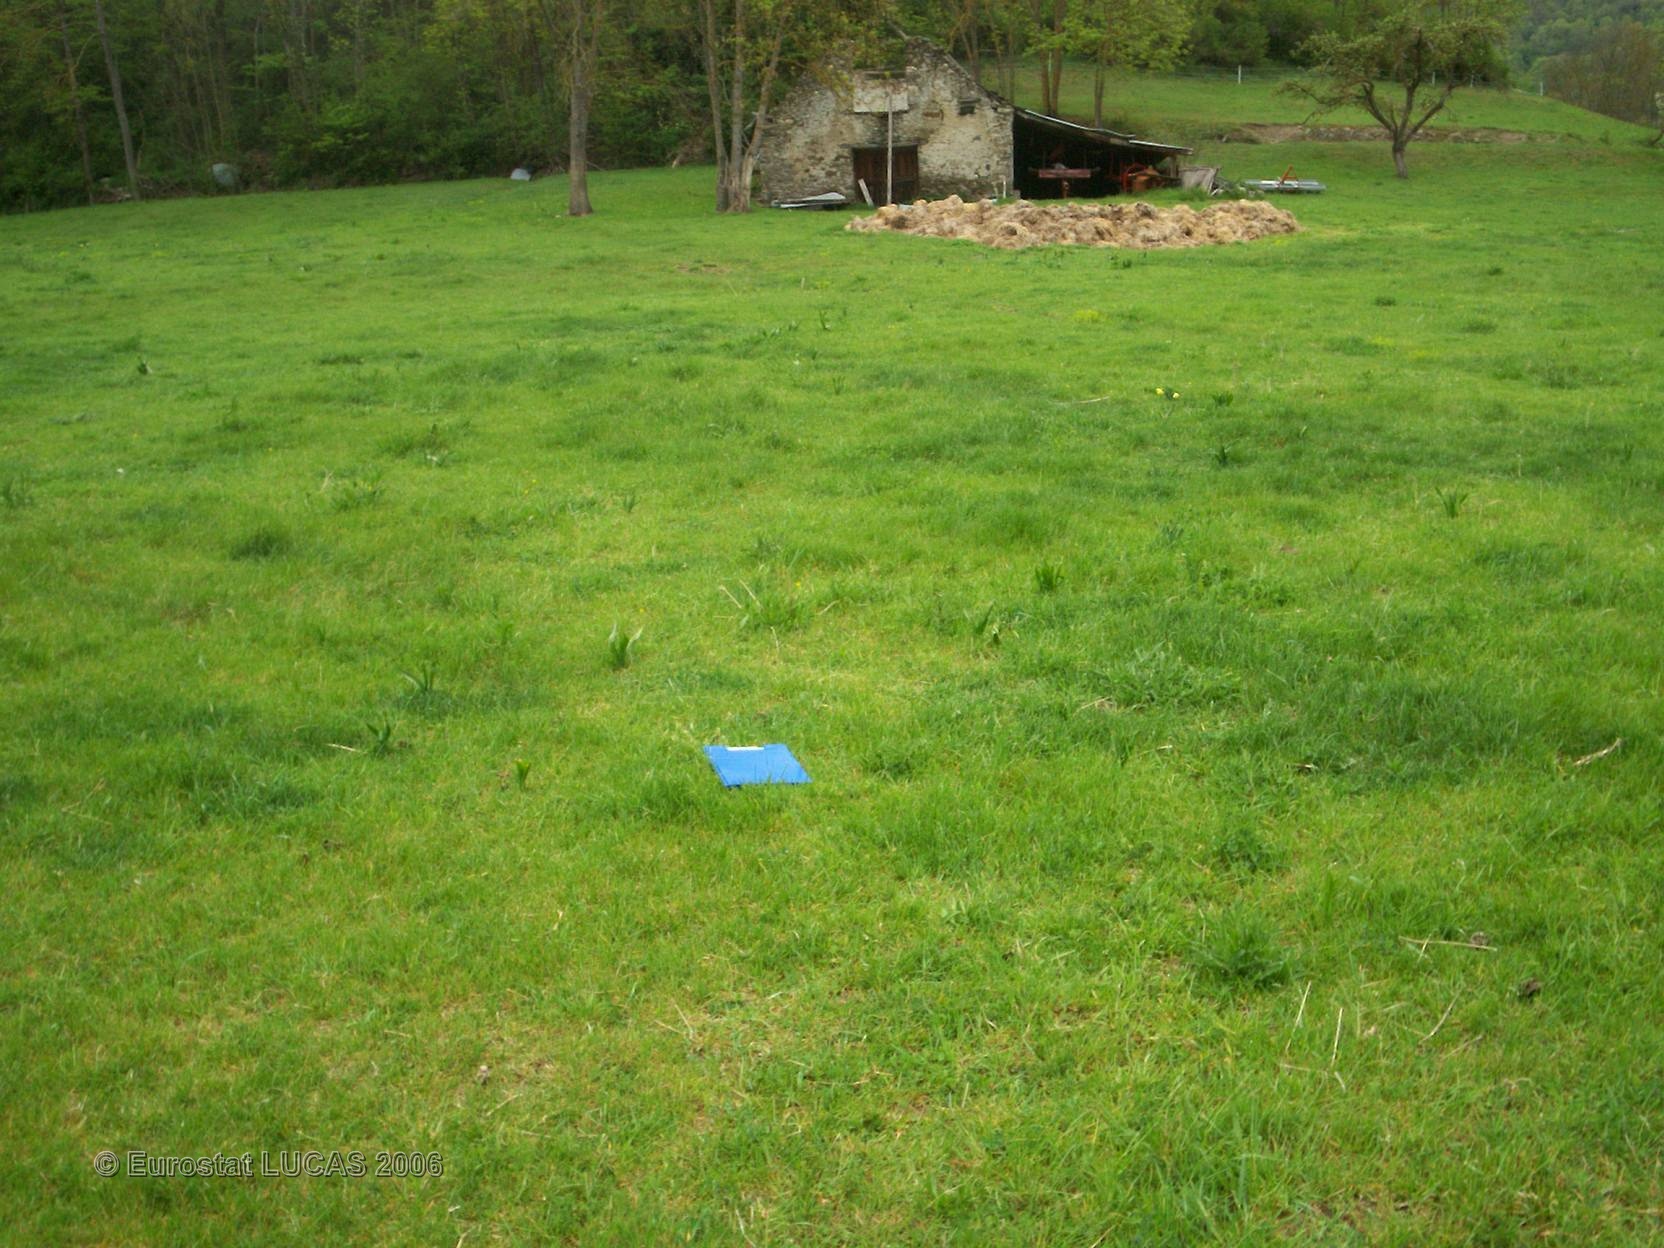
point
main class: Grassland
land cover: Grassland without tree/shrub cover
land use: Agriculture (excluding fallow land and kitchen gardens)
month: April
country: FR
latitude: 42.8641
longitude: 0.3441
